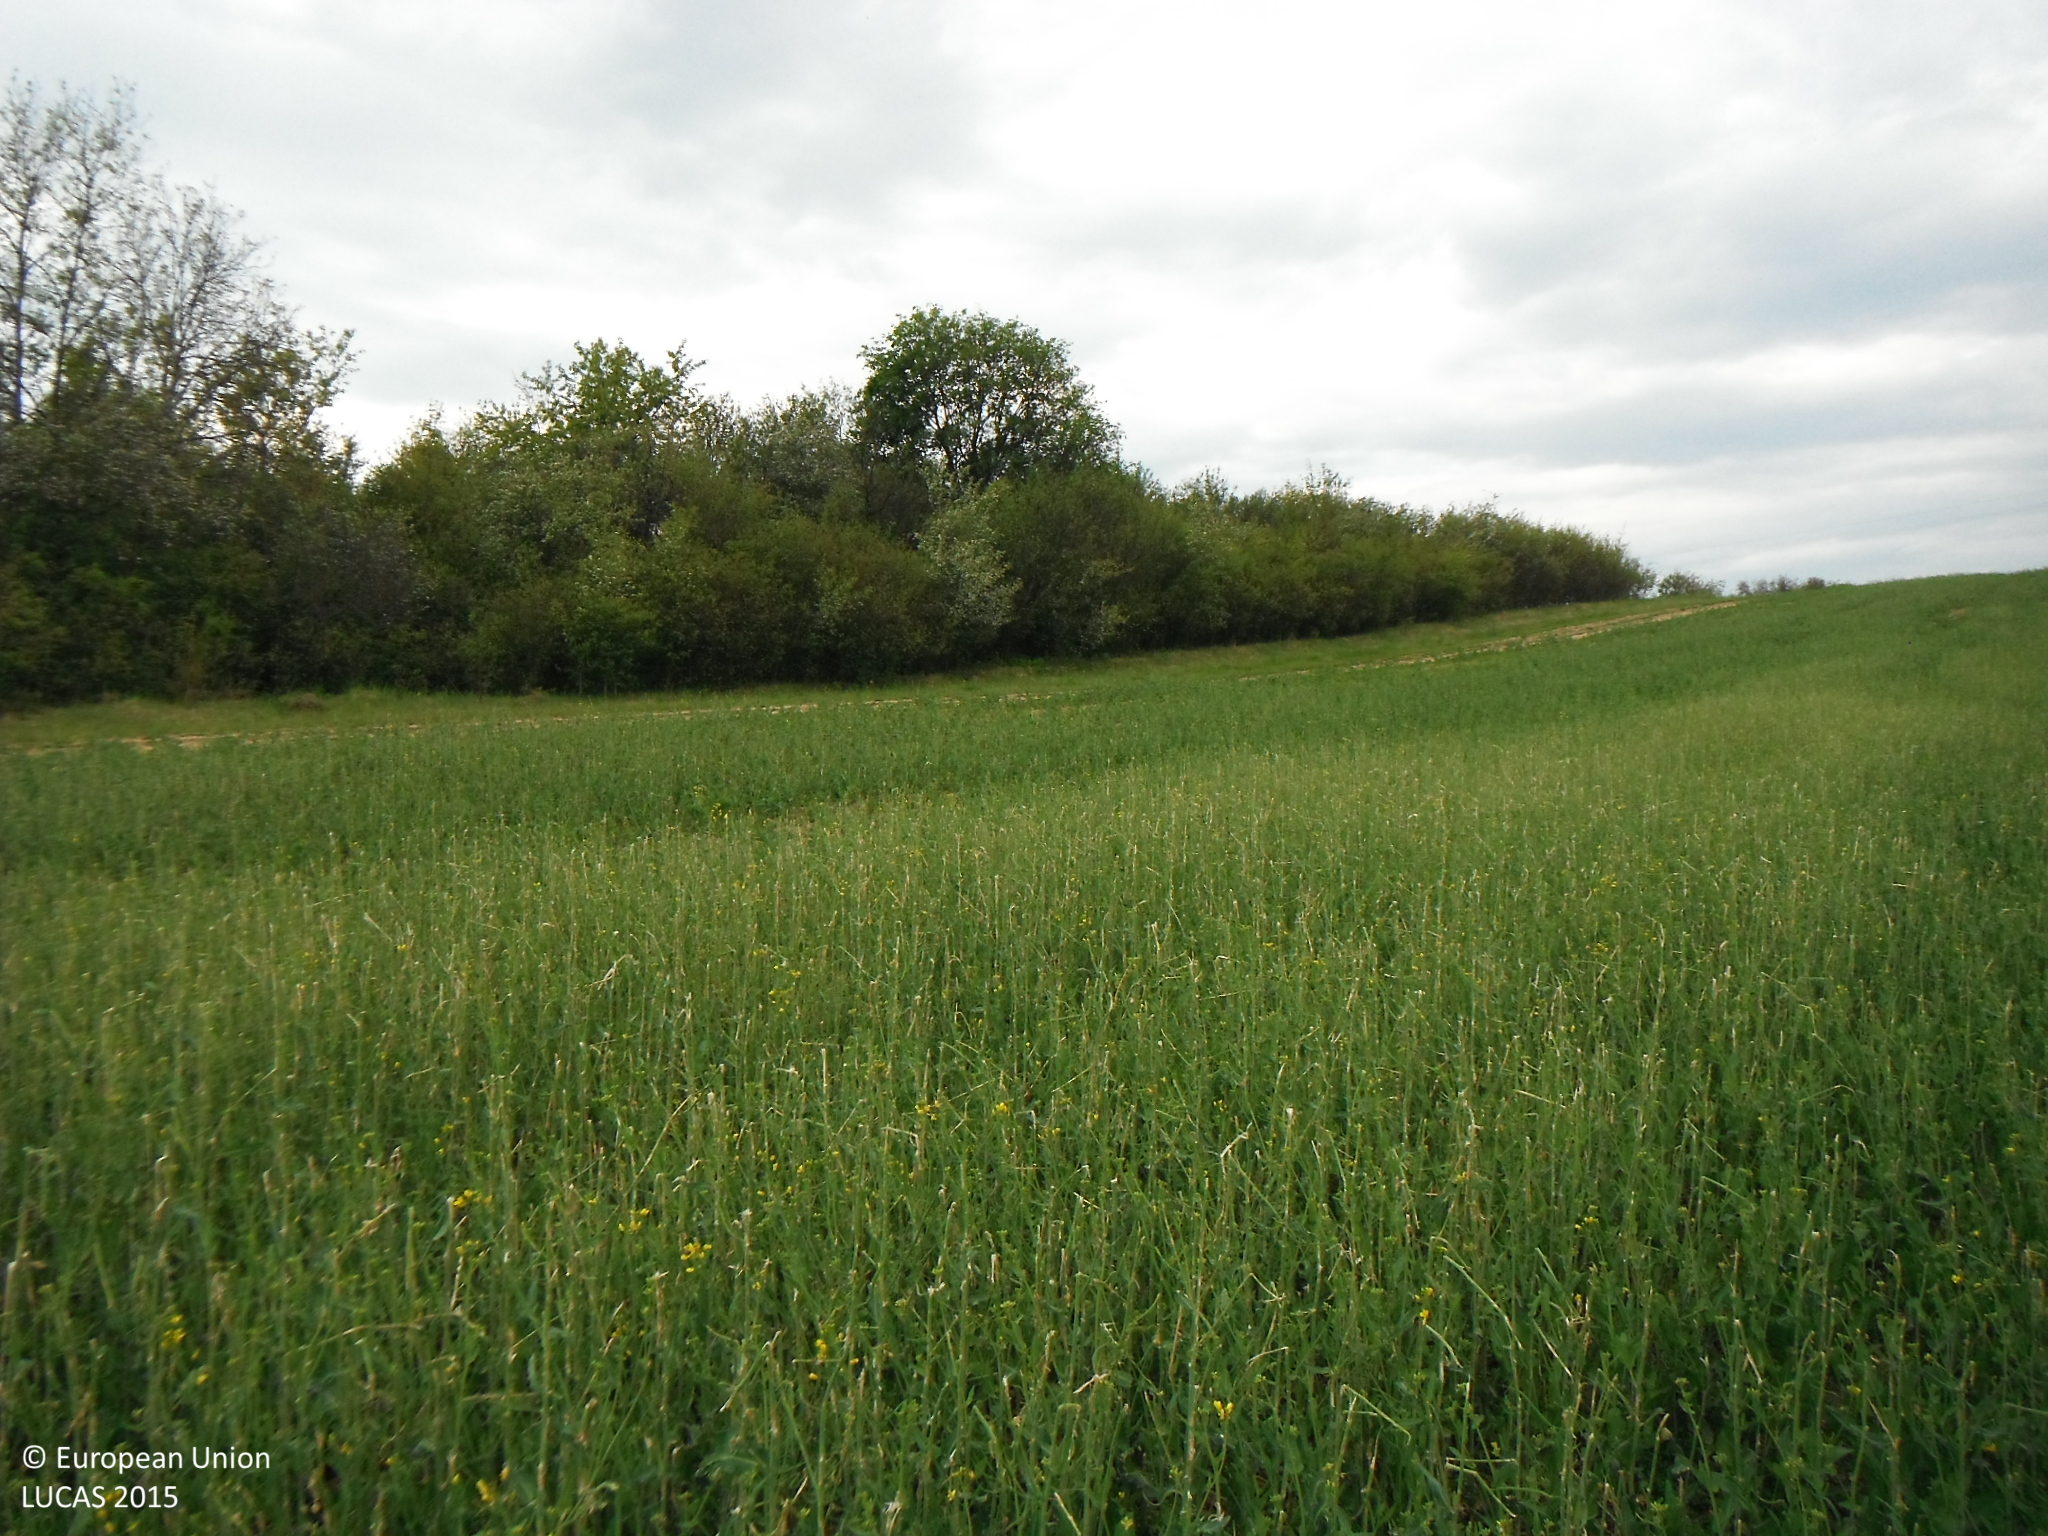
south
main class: Cropland
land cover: Rape and turnip rape
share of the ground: > 75 %
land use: Agriculture (excluding fallow land and kitchen gardens)
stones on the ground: < 10 %
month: May
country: SK
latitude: 49.0320
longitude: 21.1917
